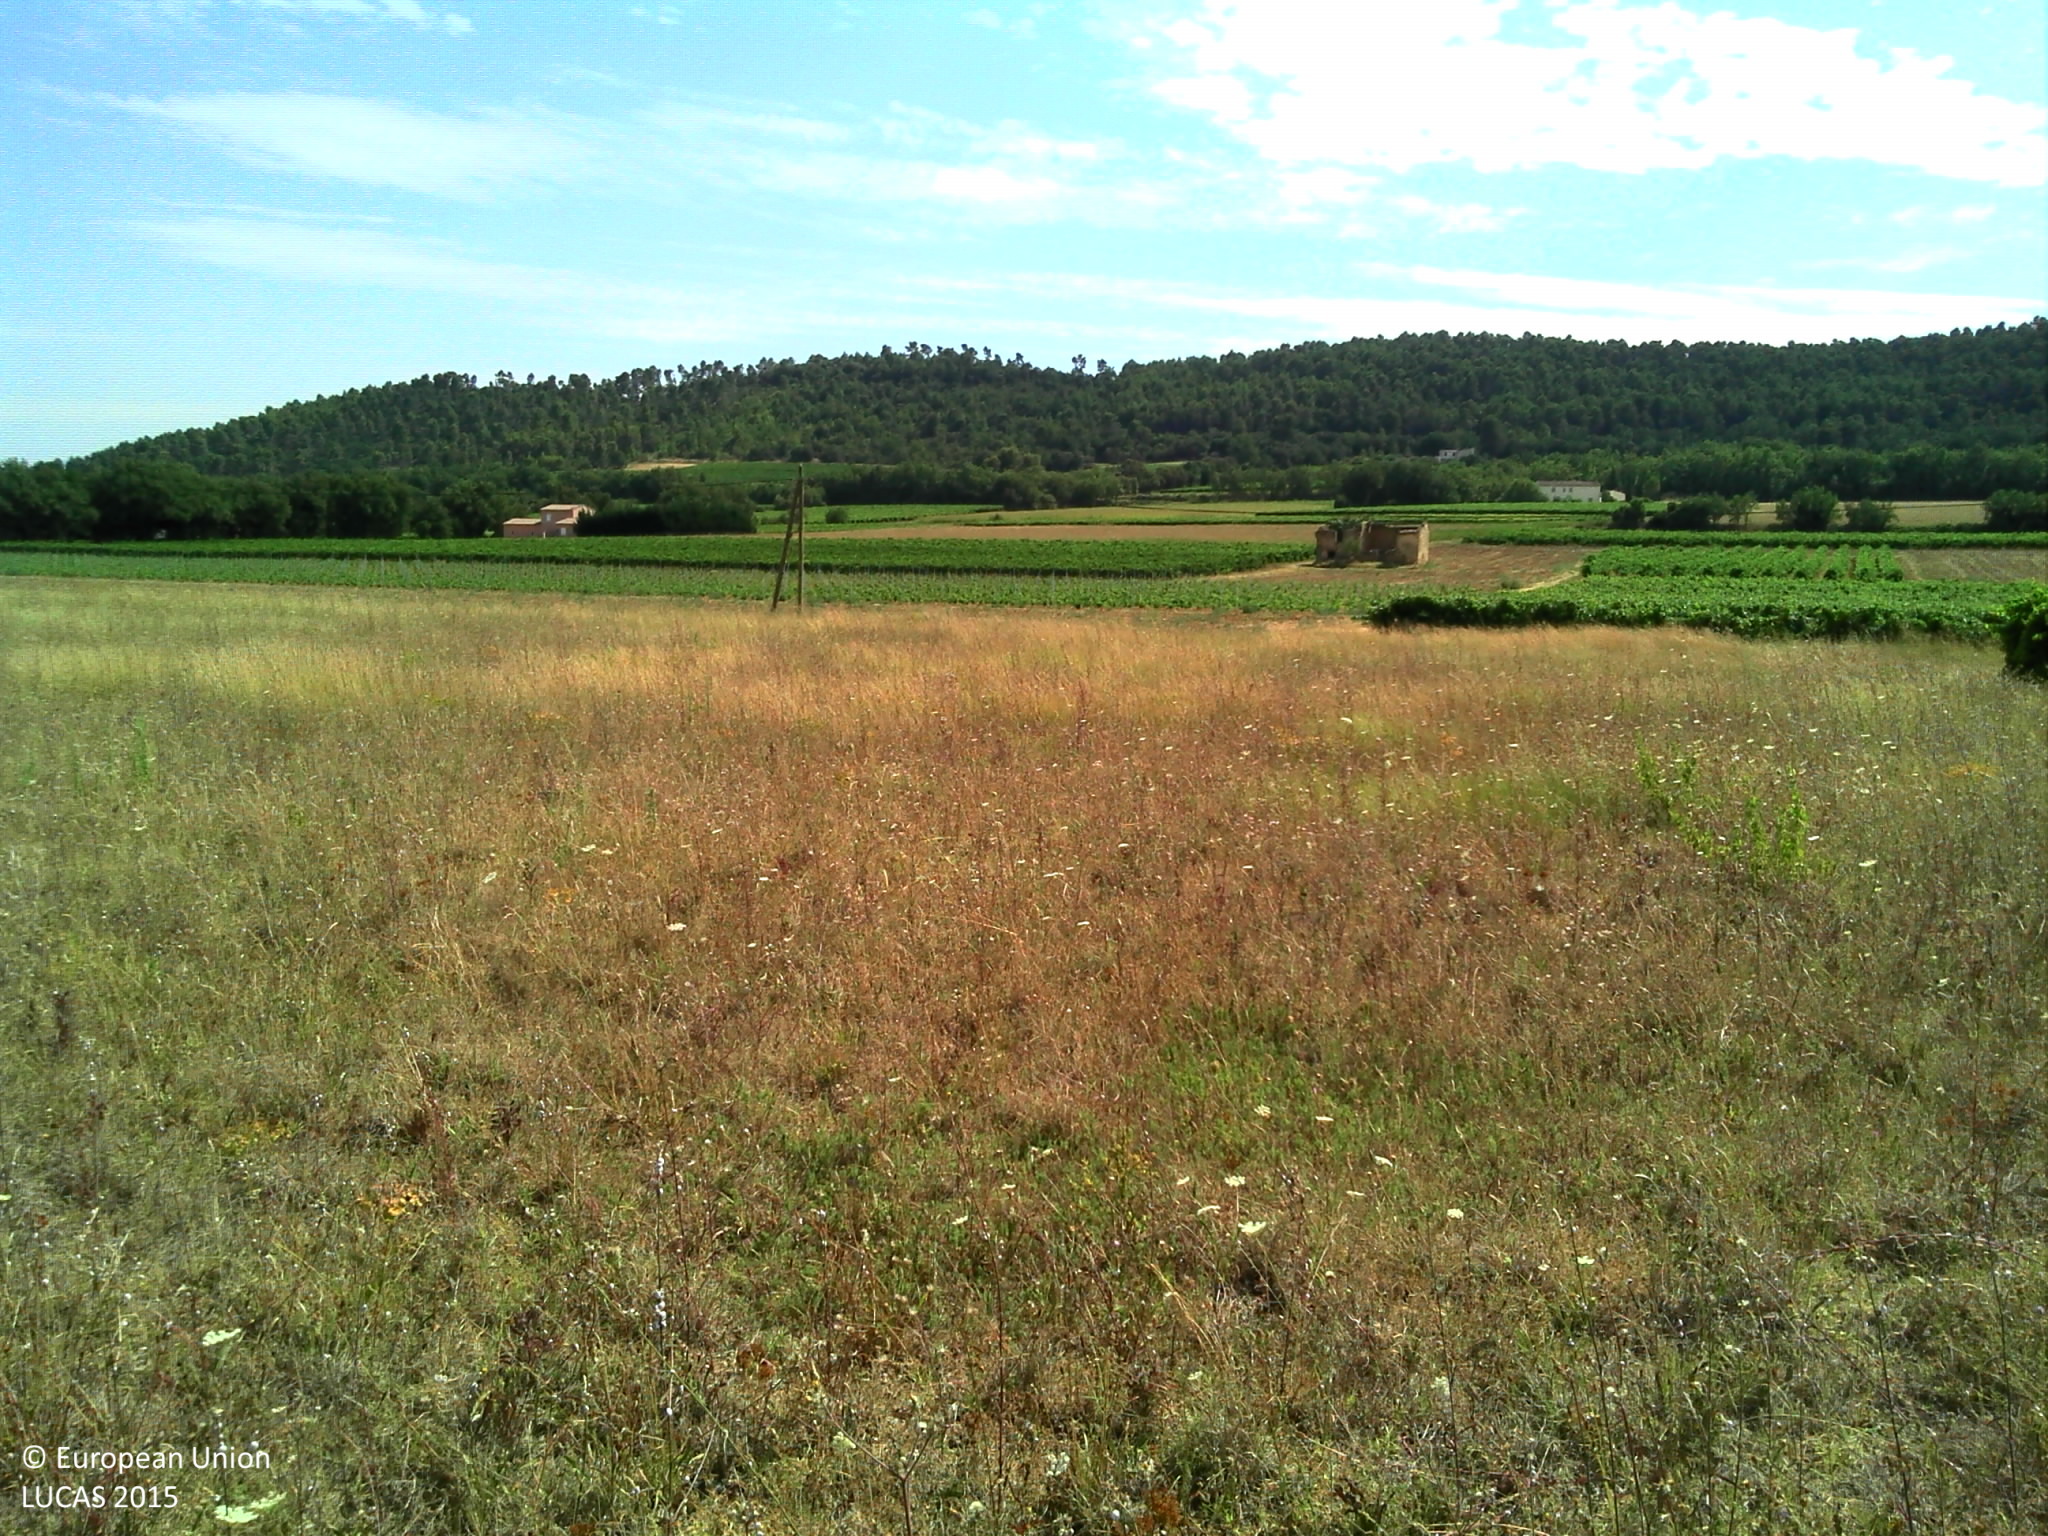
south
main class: Grassland
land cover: Grassland without tree/shrub cover
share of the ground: > 75 %
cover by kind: herbaceous plants 85 %, unconsolidated bare surface 15 %
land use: Semi-natural and natural areas not in use
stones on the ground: < 10 %
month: July
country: FR
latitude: 43.7439
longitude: 5.4270
